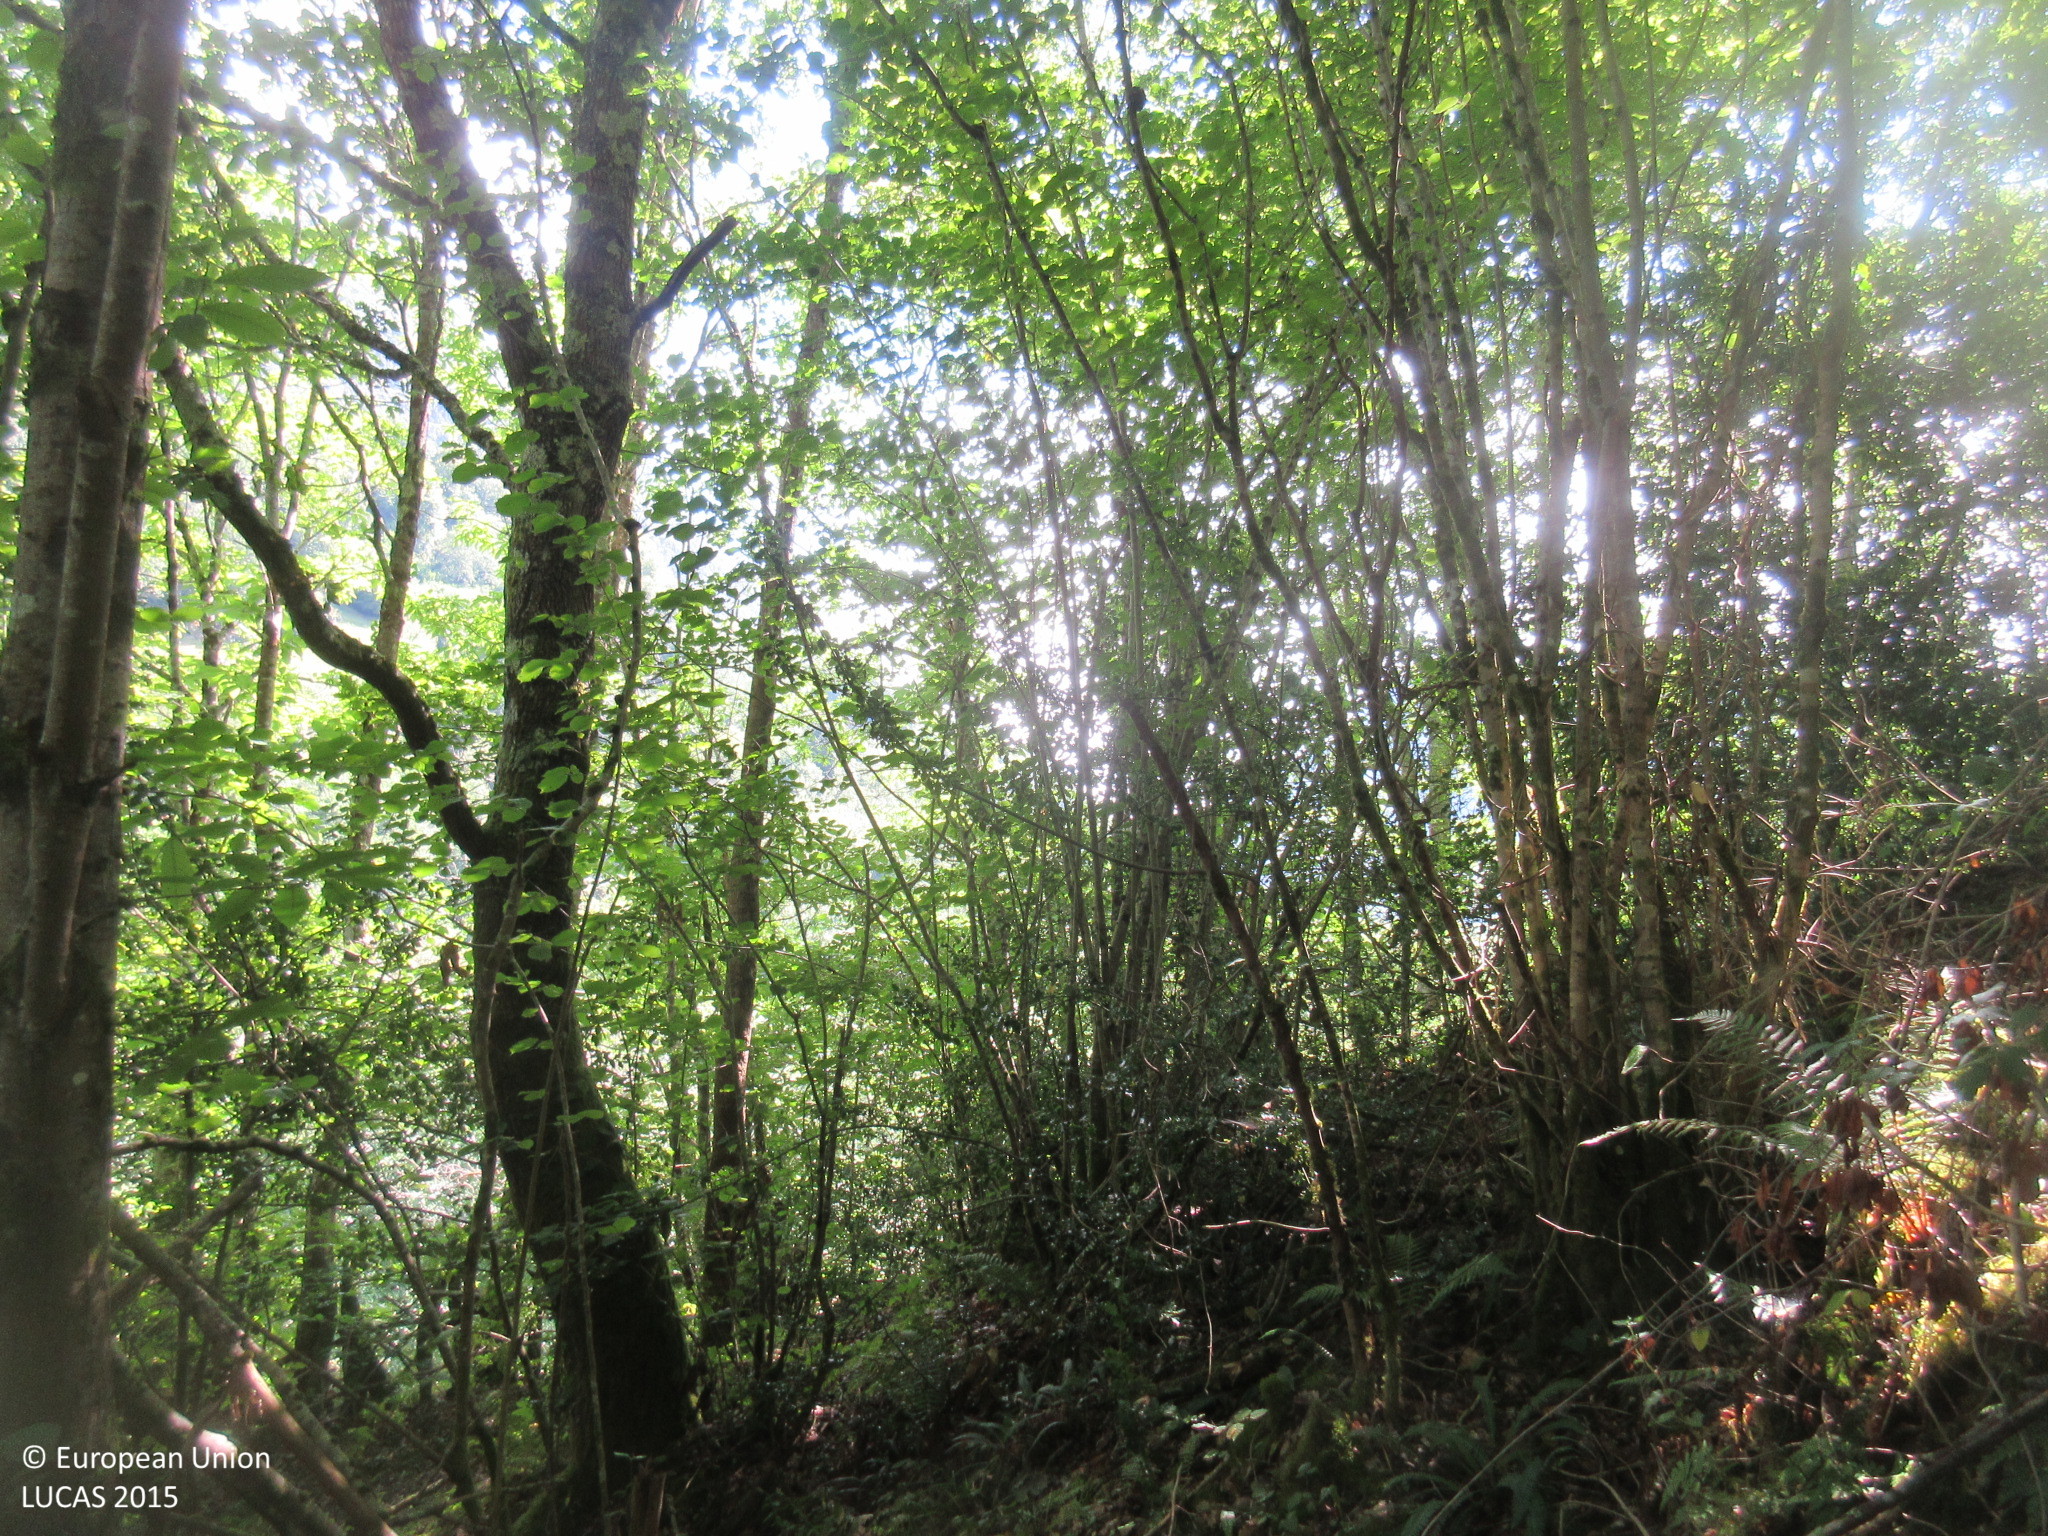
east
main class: Woodland
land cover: Broadleaved woodland
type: thermophilous deciduous forest
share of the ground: > 75 %
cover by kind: broadleaved forest trees 95 %, shrubs 5 %
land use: Semi-natural and natural areas not in use
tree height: > 5 m
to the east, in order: Broadleaved woodland; Tracks; Abandoned hedges; Fences; Grassland without tree/shrub cover; Groves
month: July
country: ES
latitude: 43.2578
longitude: -5.2122
